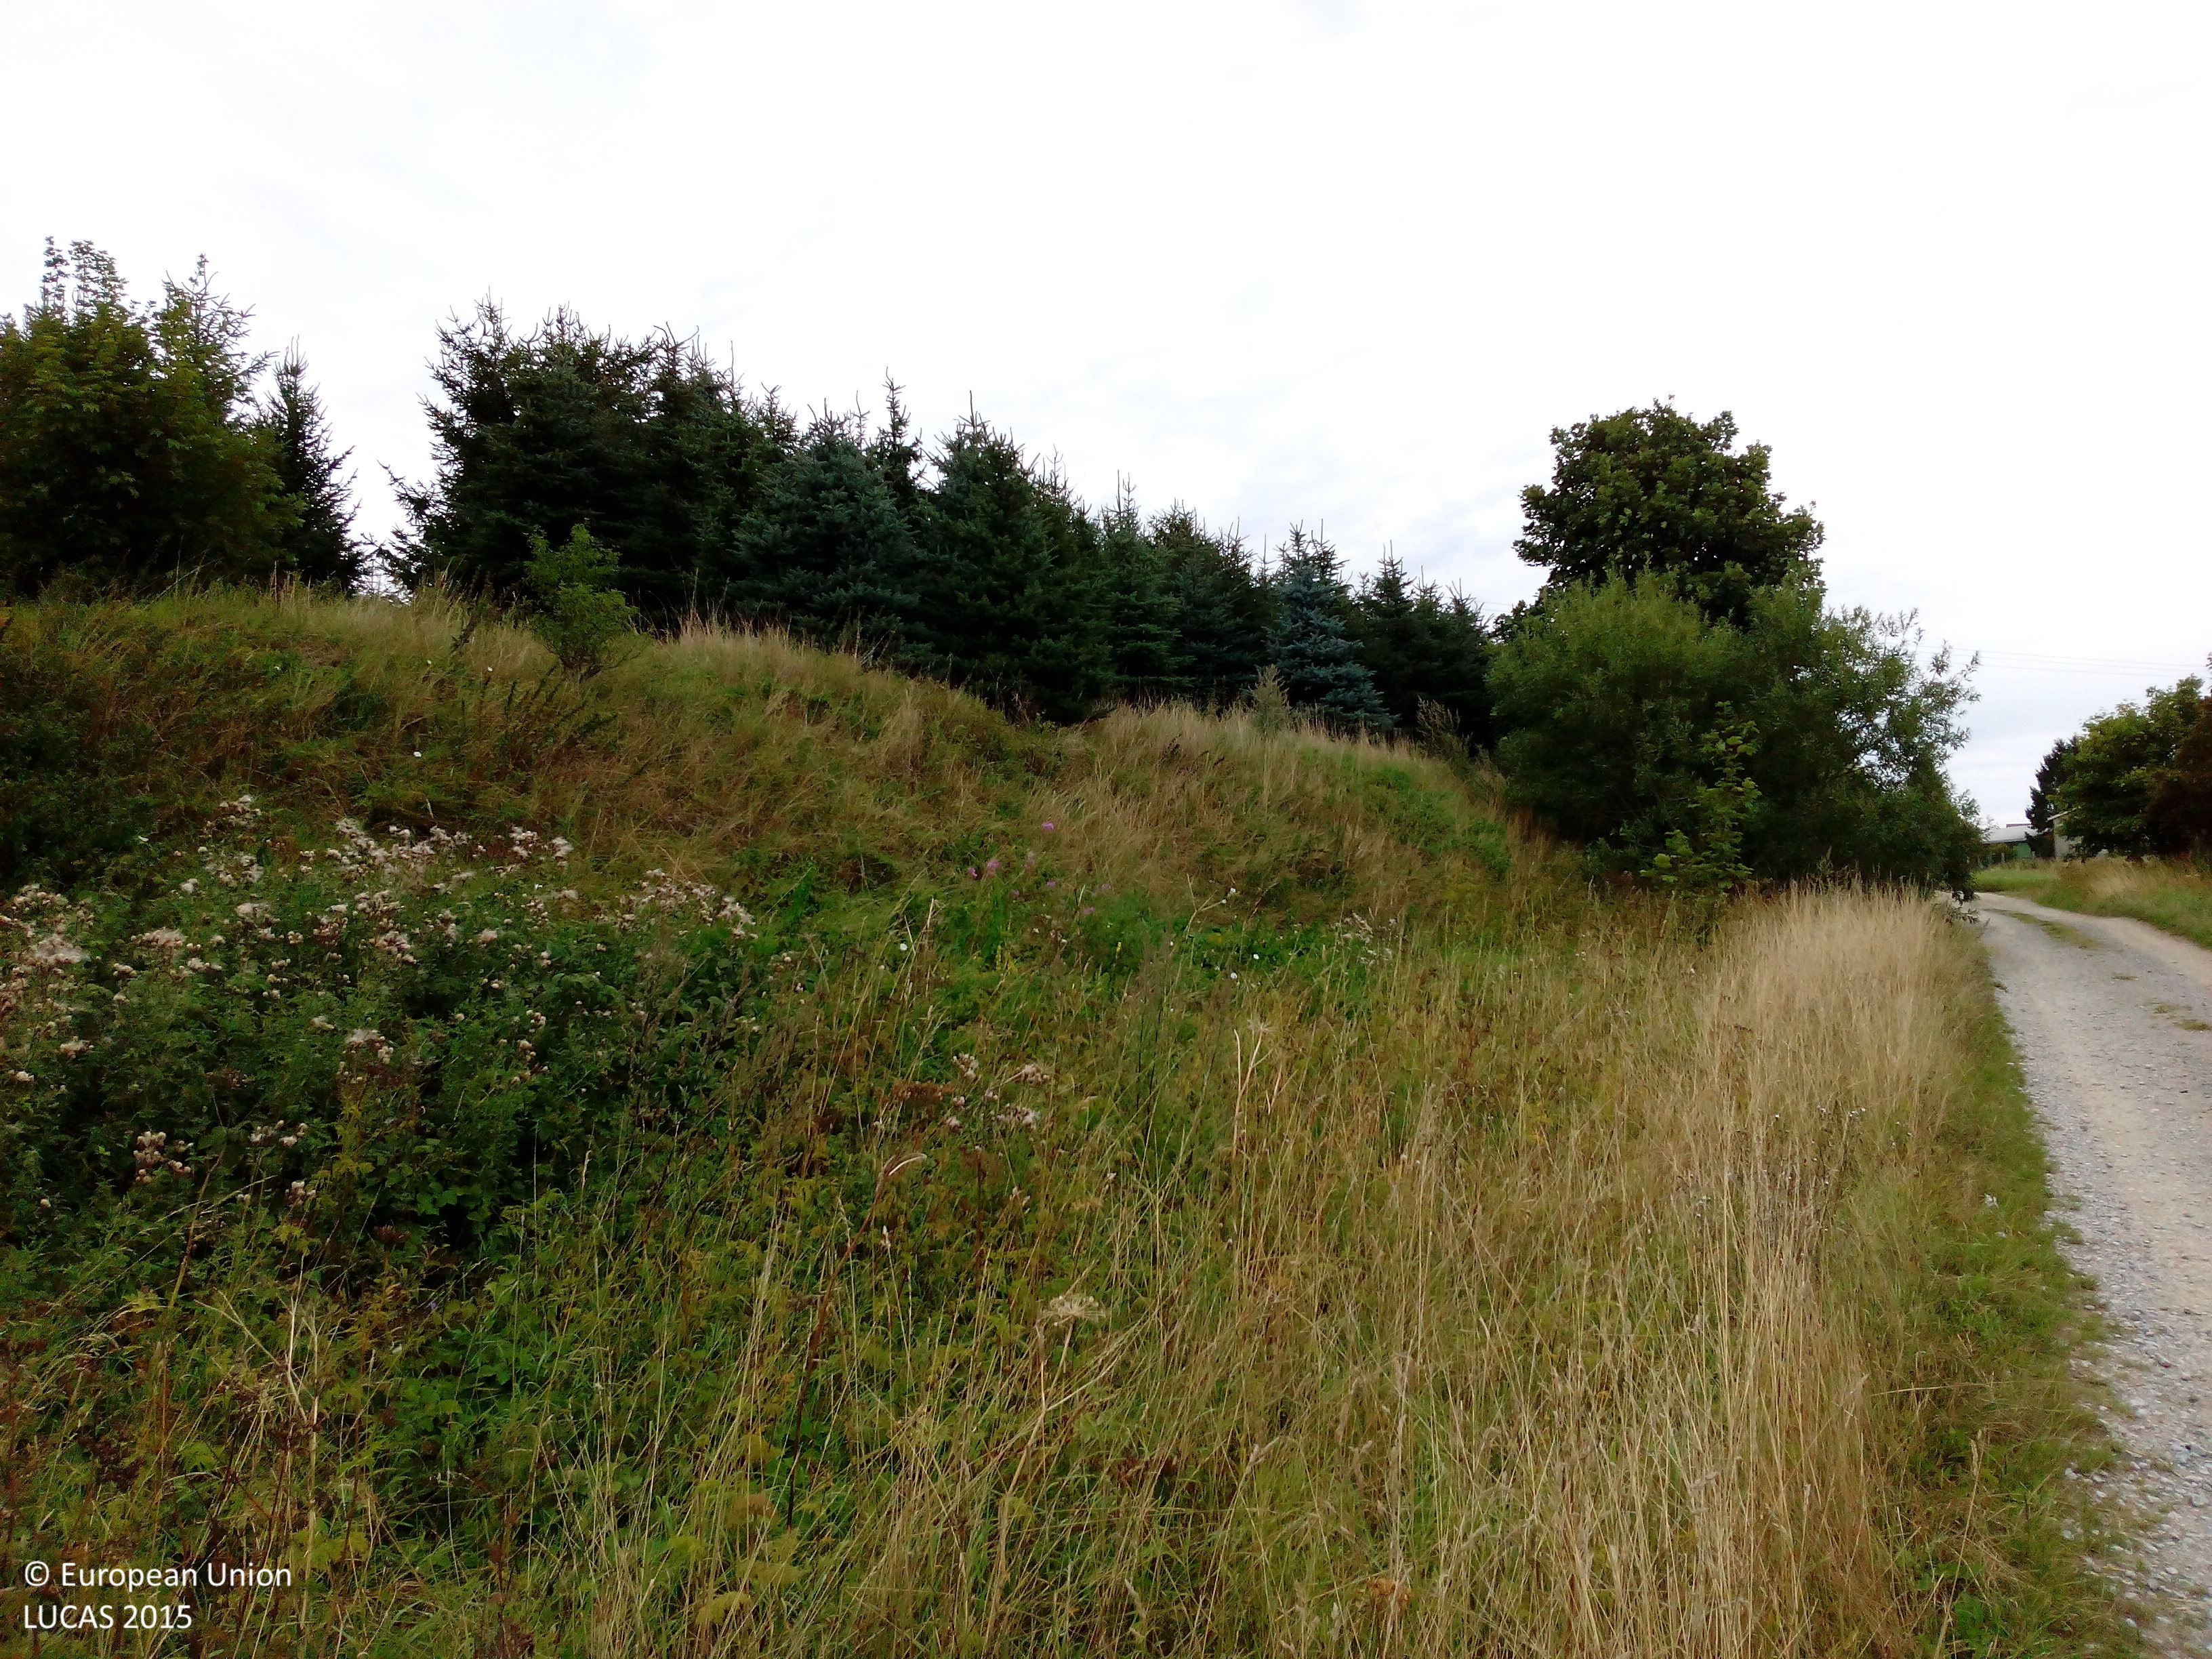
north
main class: Woodland
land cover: Other mixed woodland
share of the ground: 50 - 75 %
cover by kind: coniferous forest trees 40 %, herbaceous plants 30 %, broadleaved forest trees 25 %, shrubs 5 %
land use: Forestry
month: August
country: DE
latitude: 51.6724
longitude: 10.9686
